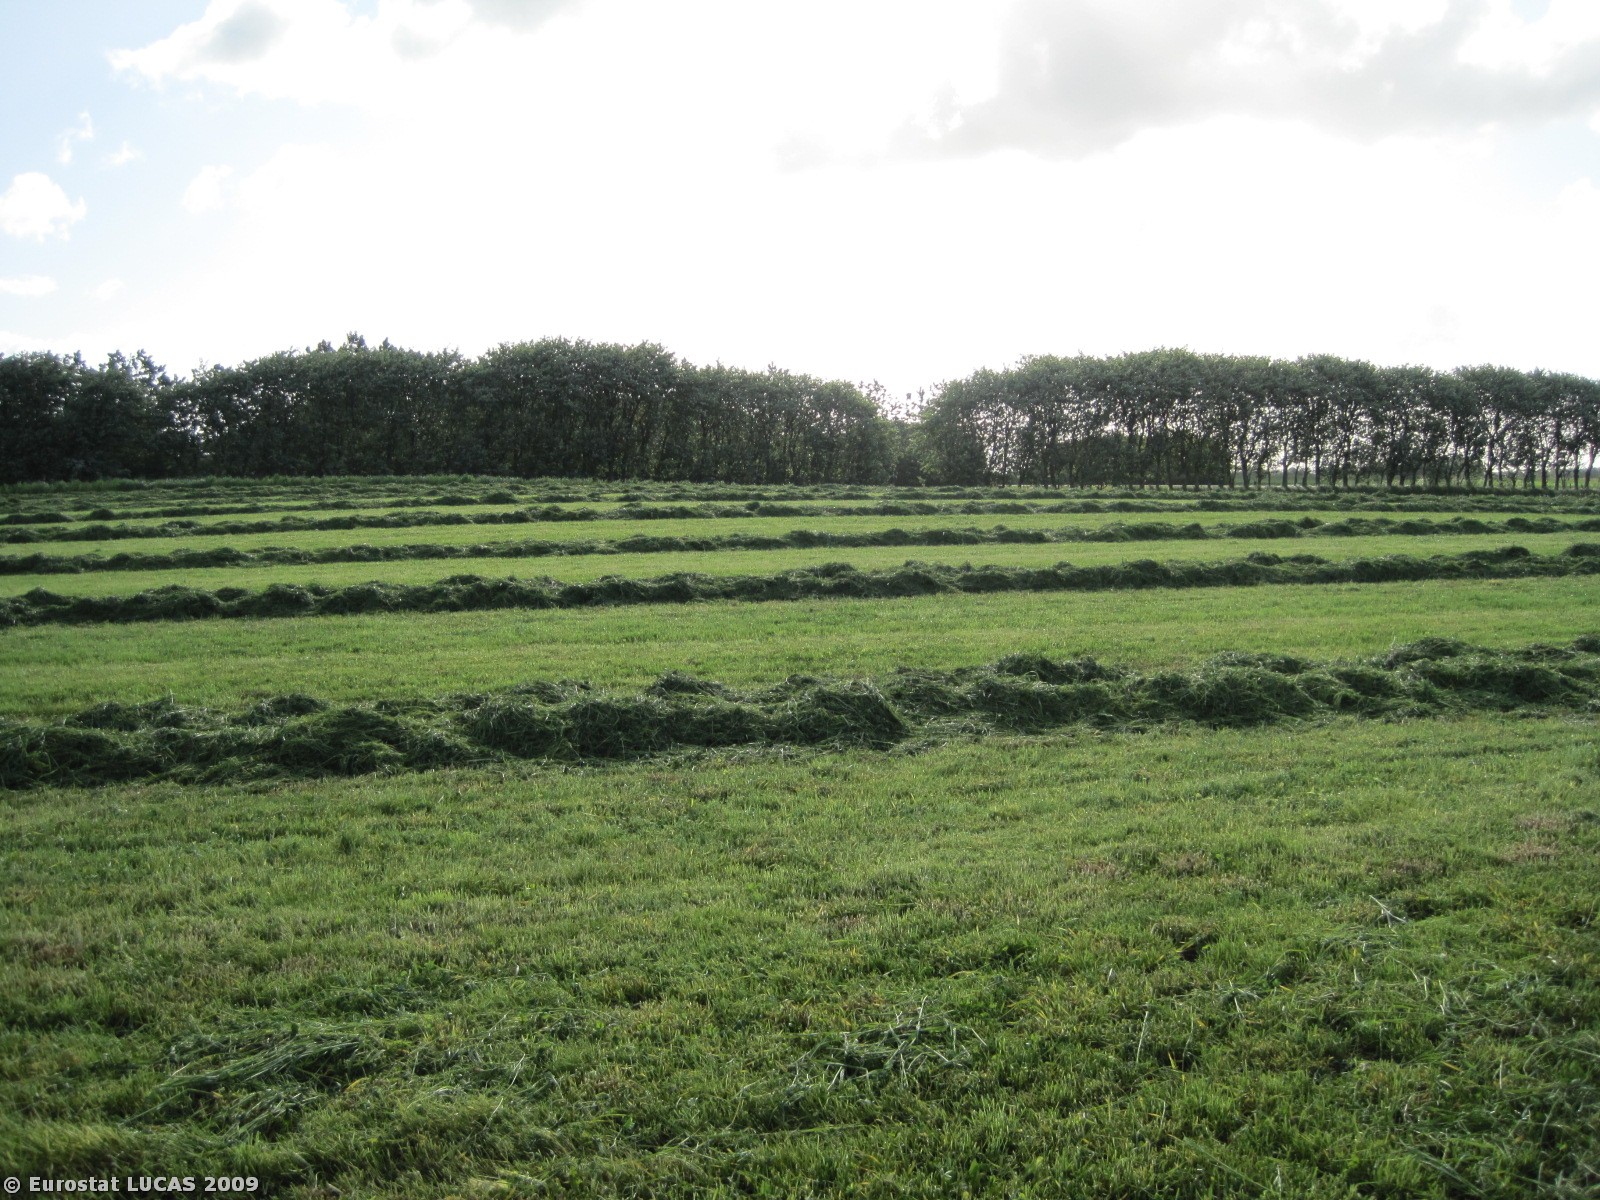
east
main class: Grassland
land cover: Grassland without tree/shrub cover
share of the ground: > 75 %
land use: Agriculture (excluding fallow land and kitchen gardens)
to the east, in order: Grassland without tree/shrub cover; Maize; Grass margins; Broadleaved woodland; Fences; Grassland without tree/shrub cover; Fences; Broadleaved woodland; Managed hedges; Grass margins; Paved roads, cycling and walking lanes; Grass margins; Managed hedges; Grassland without tree/shrub cover; Artificial constructions in urban areas; Grassland without tree/shrub cover; Barley
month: May
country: DK
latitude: 56.5111
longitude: 9.7566
